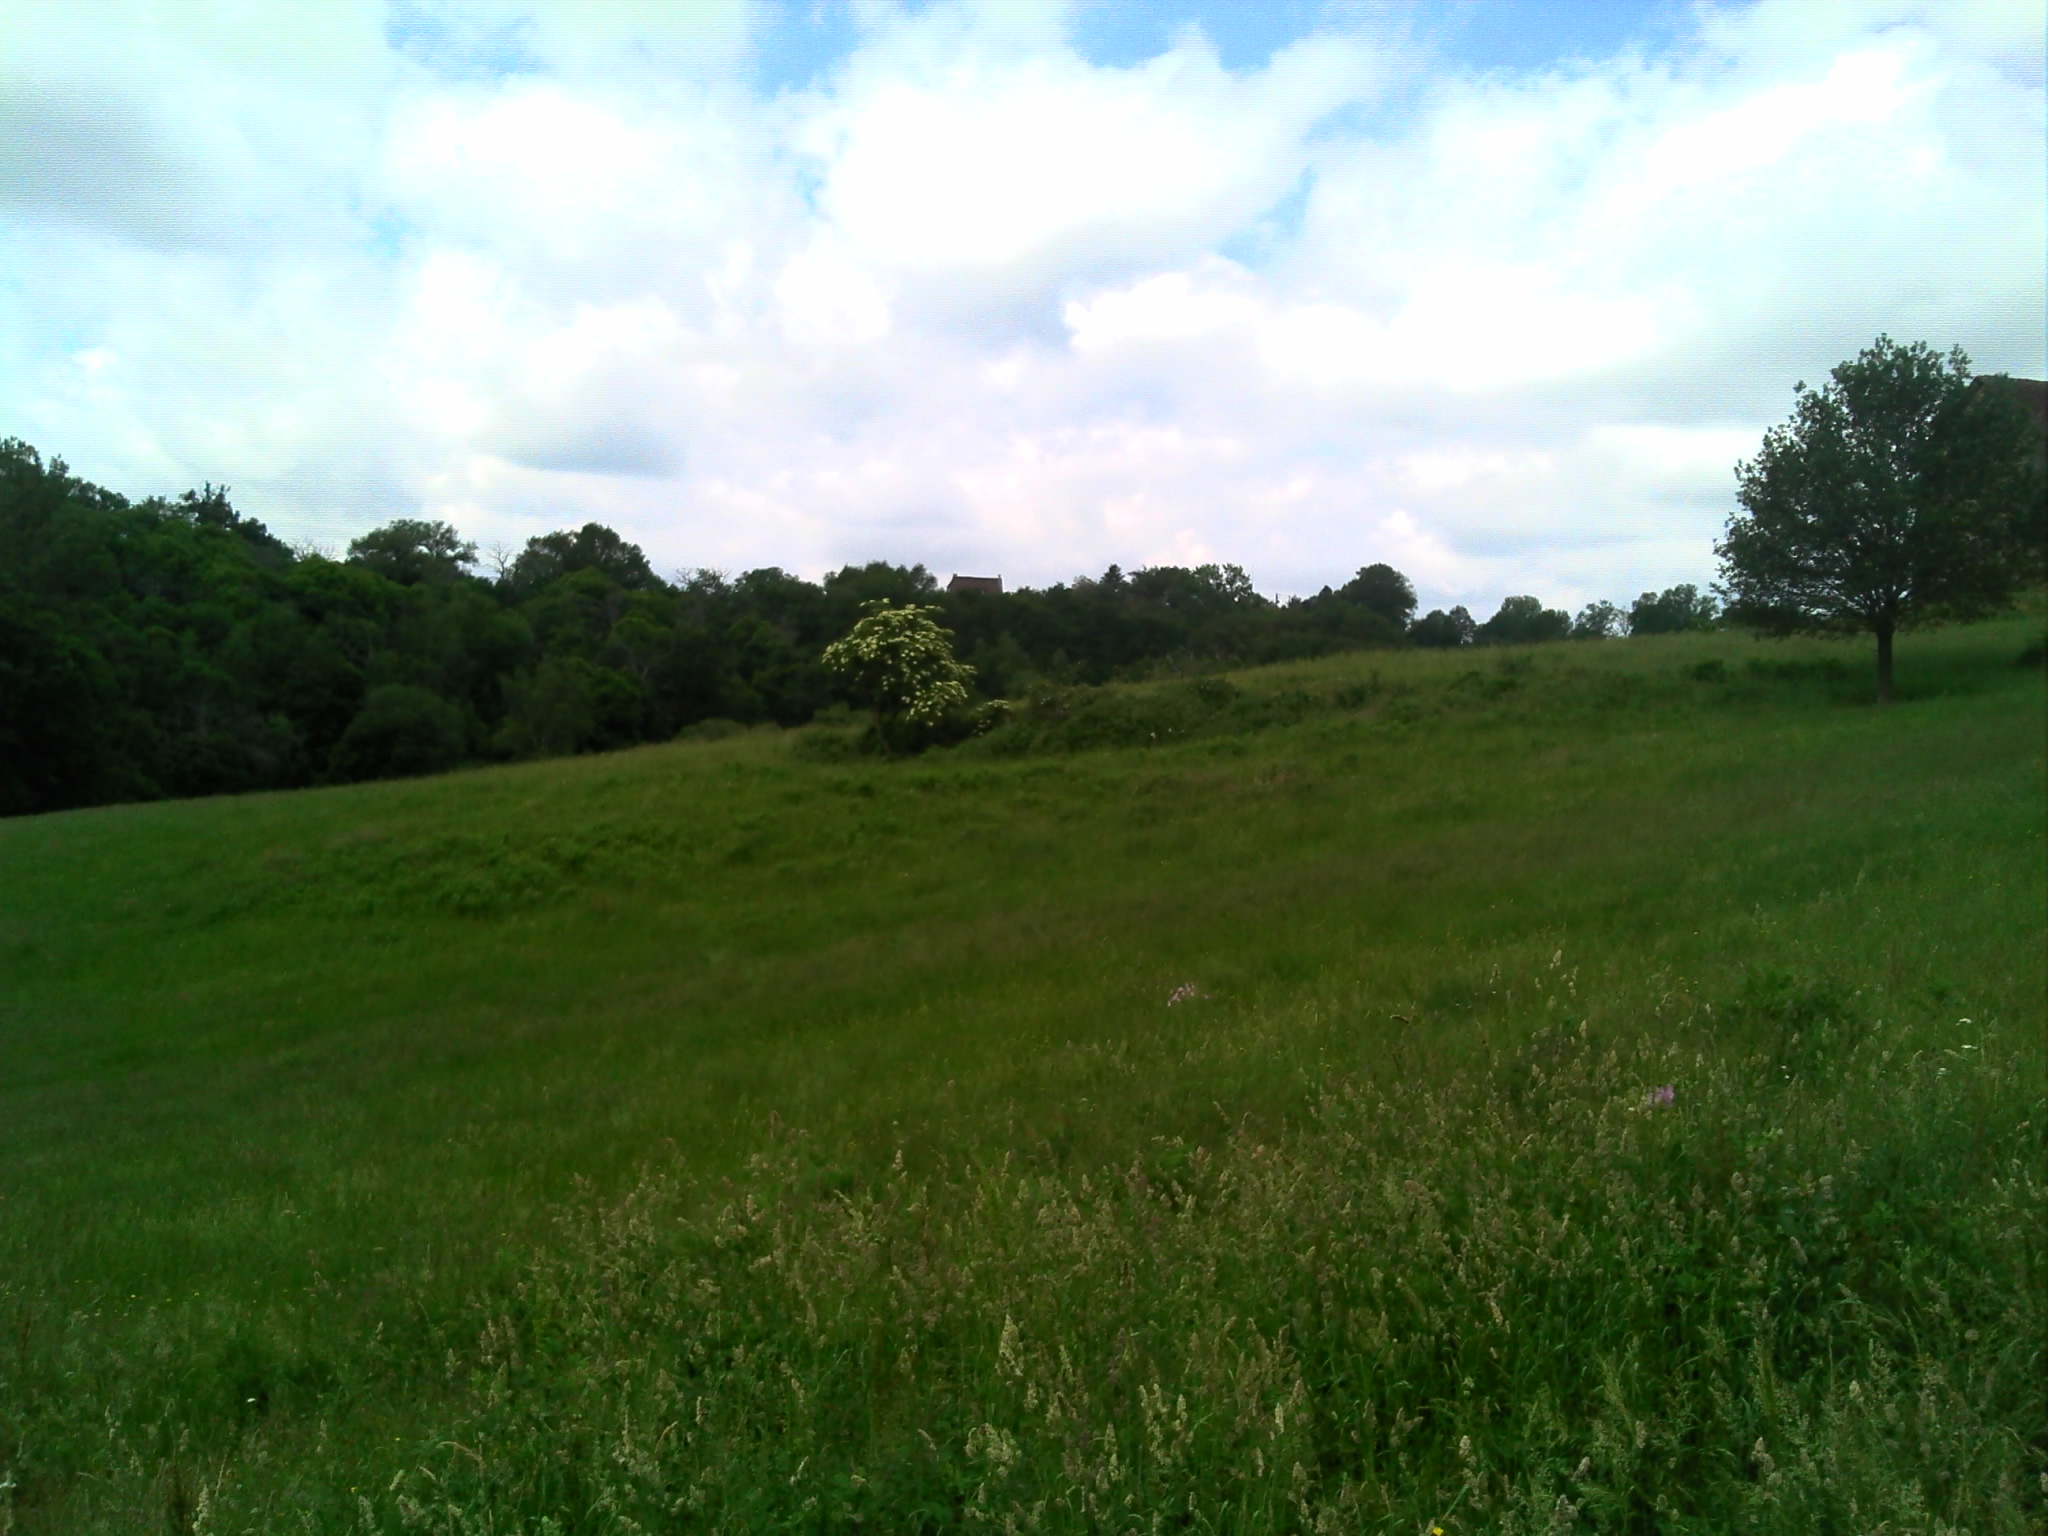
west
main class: Grassland
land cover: Grassland without tree/shrub cover
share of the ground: > 75 %
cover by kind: herbaceous plants 100 %
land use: Agriculture (excluding fallow land and kitchen gardens)
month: June
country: FR
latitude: 44.6925
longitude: 1.9868
